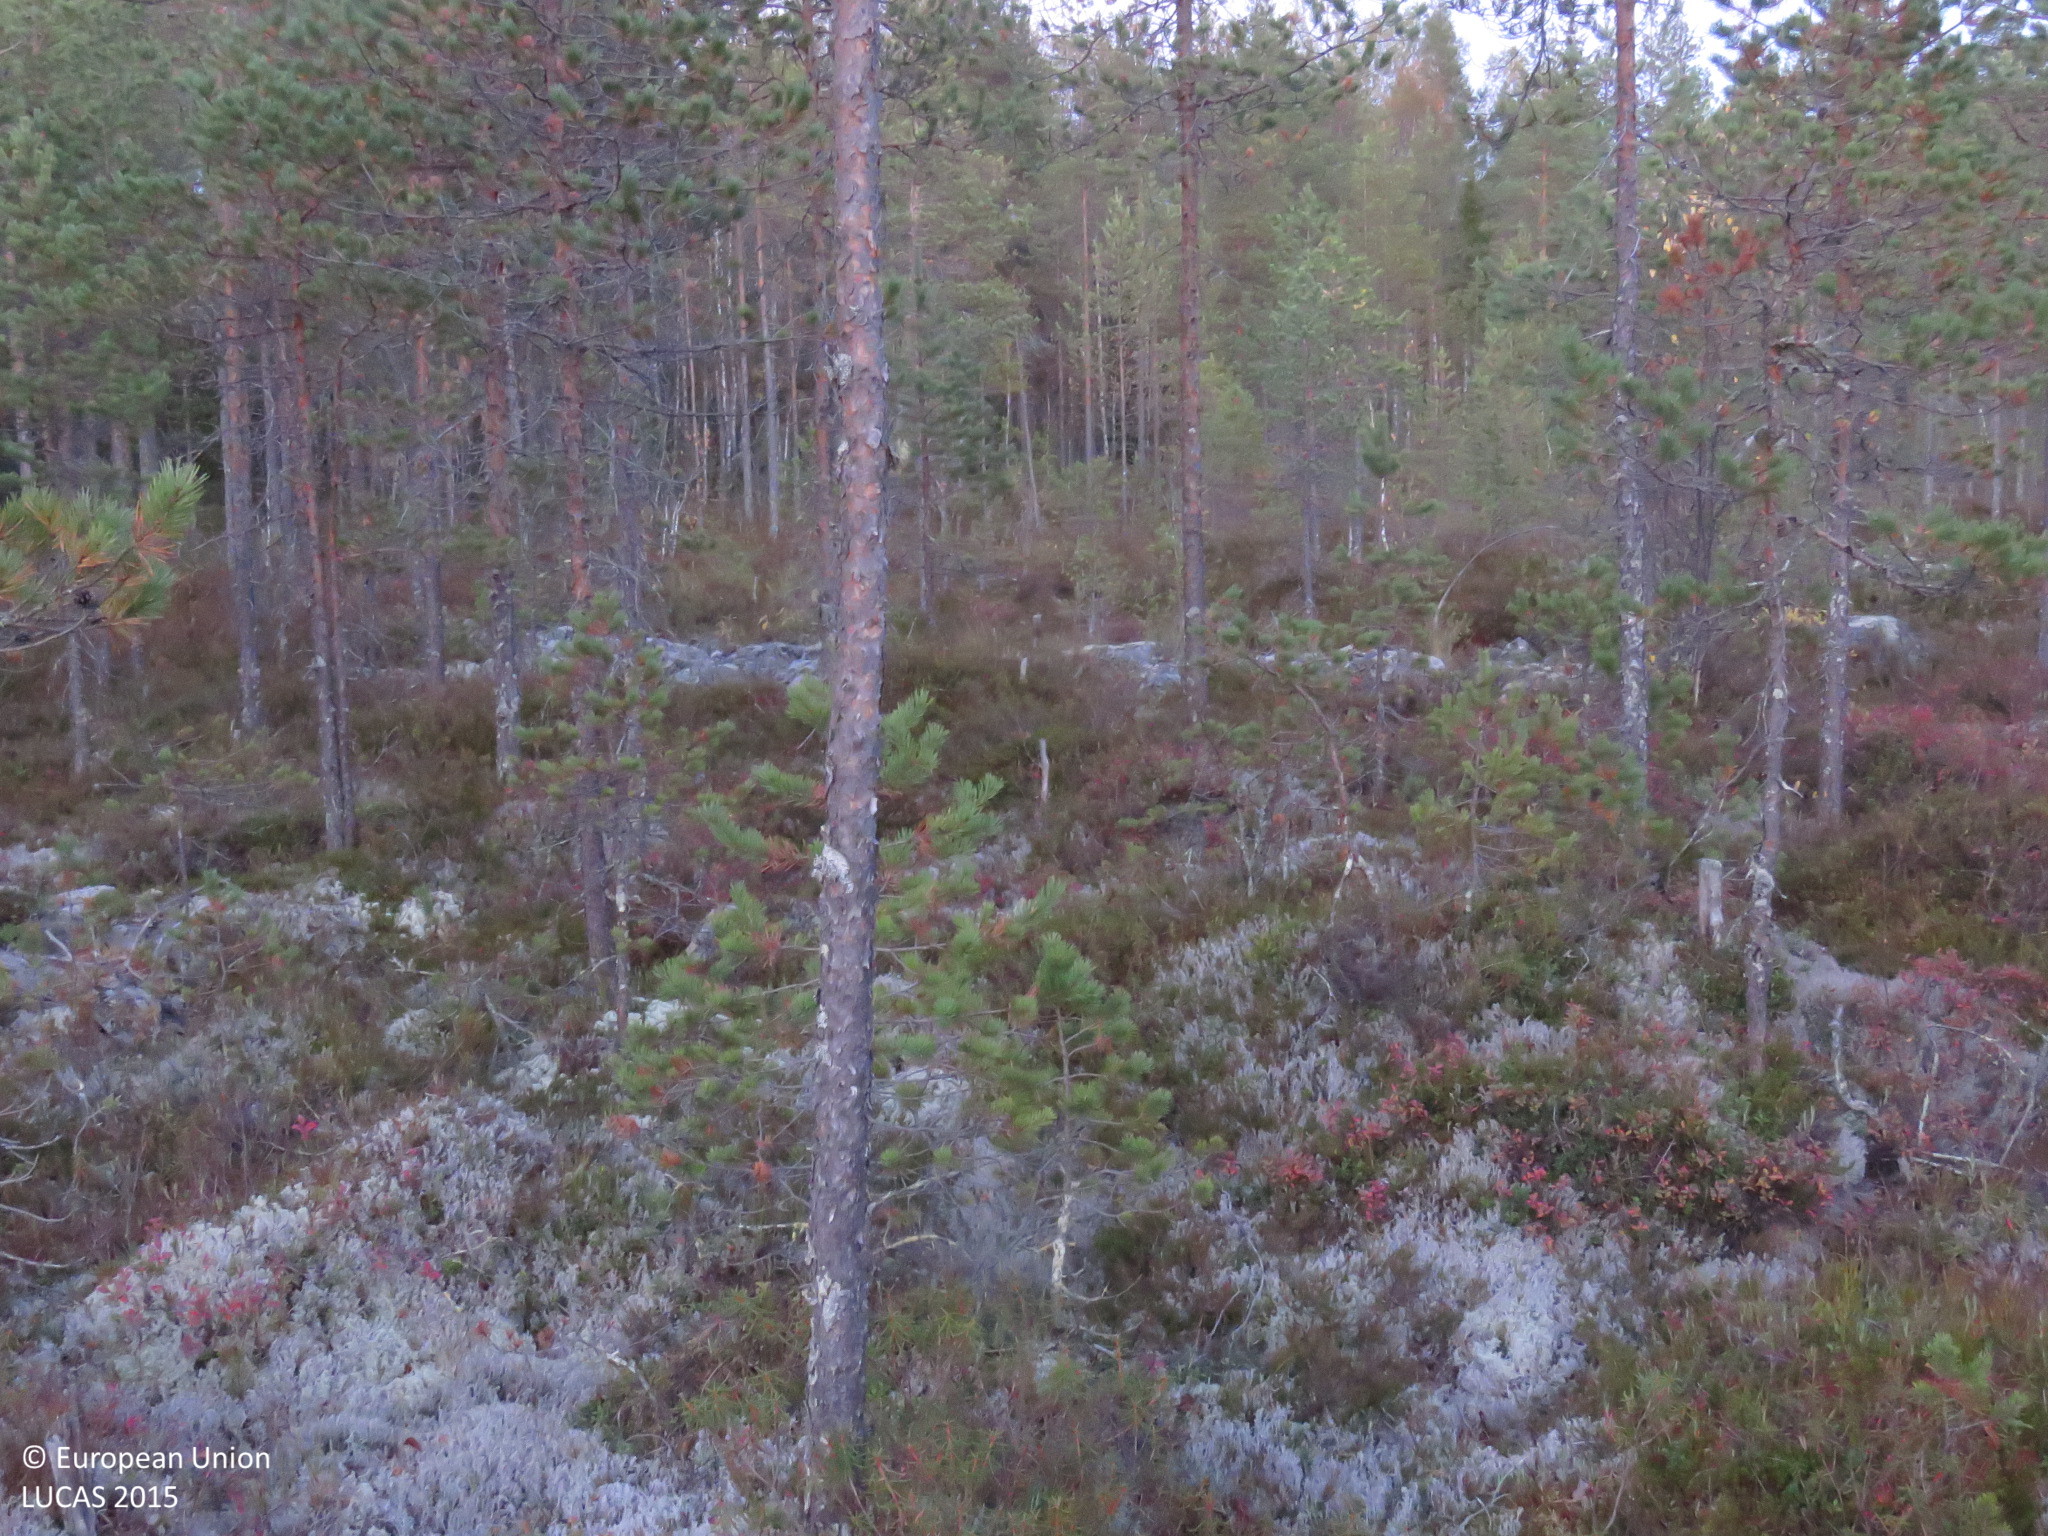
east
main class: Woodland
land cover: Pine dominated coniferous woodland
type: boreal forest
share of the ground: 50 - 75 %
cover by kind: coniferous forest trees 65 %, shrubs 15 %, lichens and mosses 15 %, herbaceous plants 5 %
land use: Semi-natural and natural areas not in use
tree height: < 5 m
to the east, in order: Pine dominated coniferous woodland; Ditches and canals; Pine dominated coniferous woodland; Other mixed woodland; Grass margins; Tracks; Broadleaved woodland; Grass margins; Ditches and canals; Grass margins; Paved roads, cycling and walking lanes; Grassland without tree/shrub cover; Grass margins; Ditches and canals; Tracks; Broadleaved woodland; Rivers and streams; Broadleaved woodland; Shruby margins; Temporary grasslands; Shruby margins; Ditches and canals; Grass margins; Tracks
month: September
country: FI
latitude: 64.8040
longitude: 26.5109
